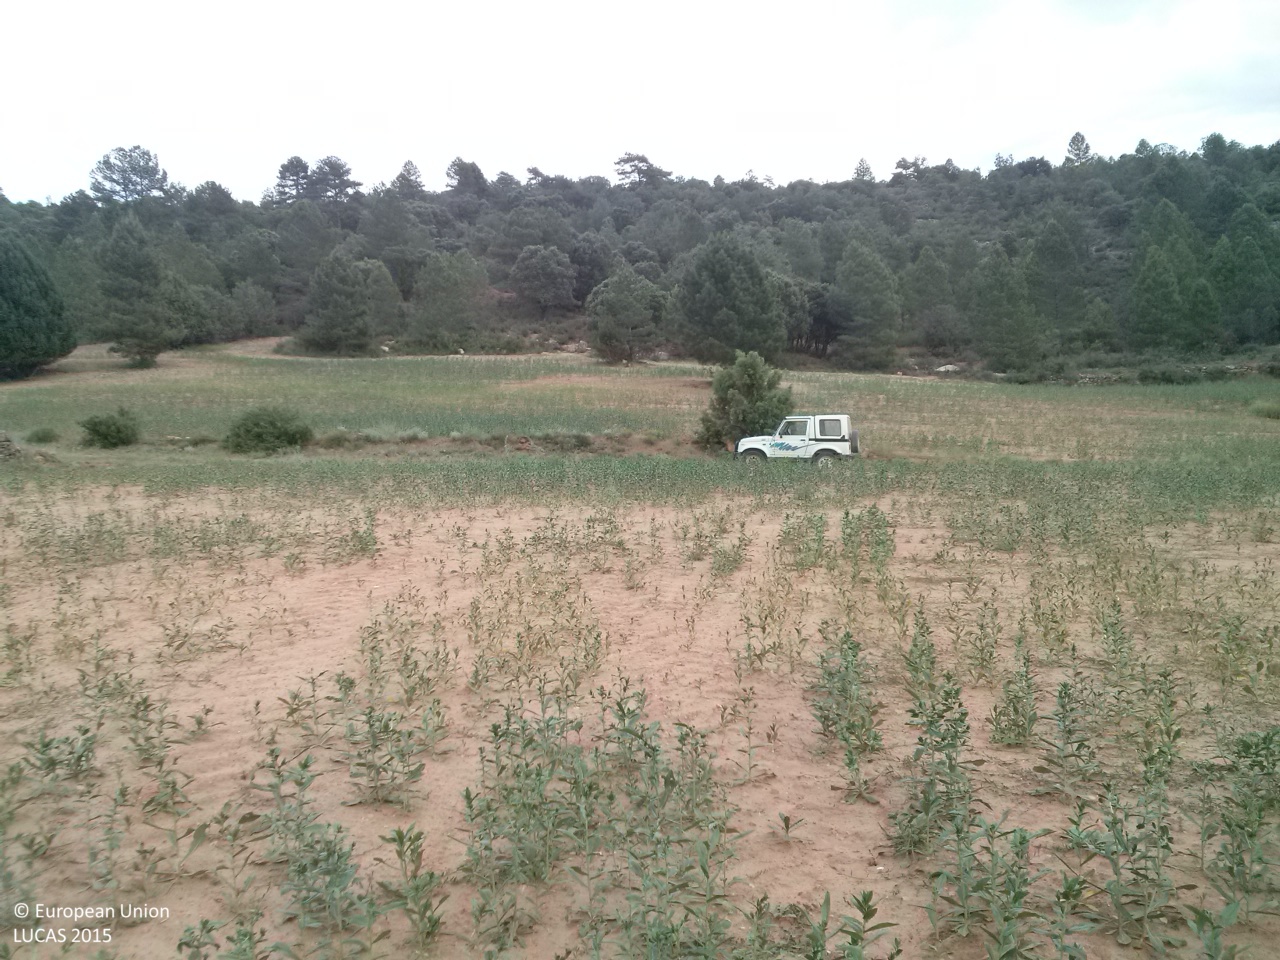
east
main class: Cropland
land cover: Other fibre and oleaginous crops
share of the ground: > 75 %
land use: Agriculture (excluding fallow land and kitchen gardens)
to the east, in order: Other fibre and oleaginous crops; Grass margins; Tracks; Grass margins; Other fibre and oleaginous crops; Pine dominated mixed woodland
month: June
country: ES
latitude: 39.9629
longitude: -1.7297
